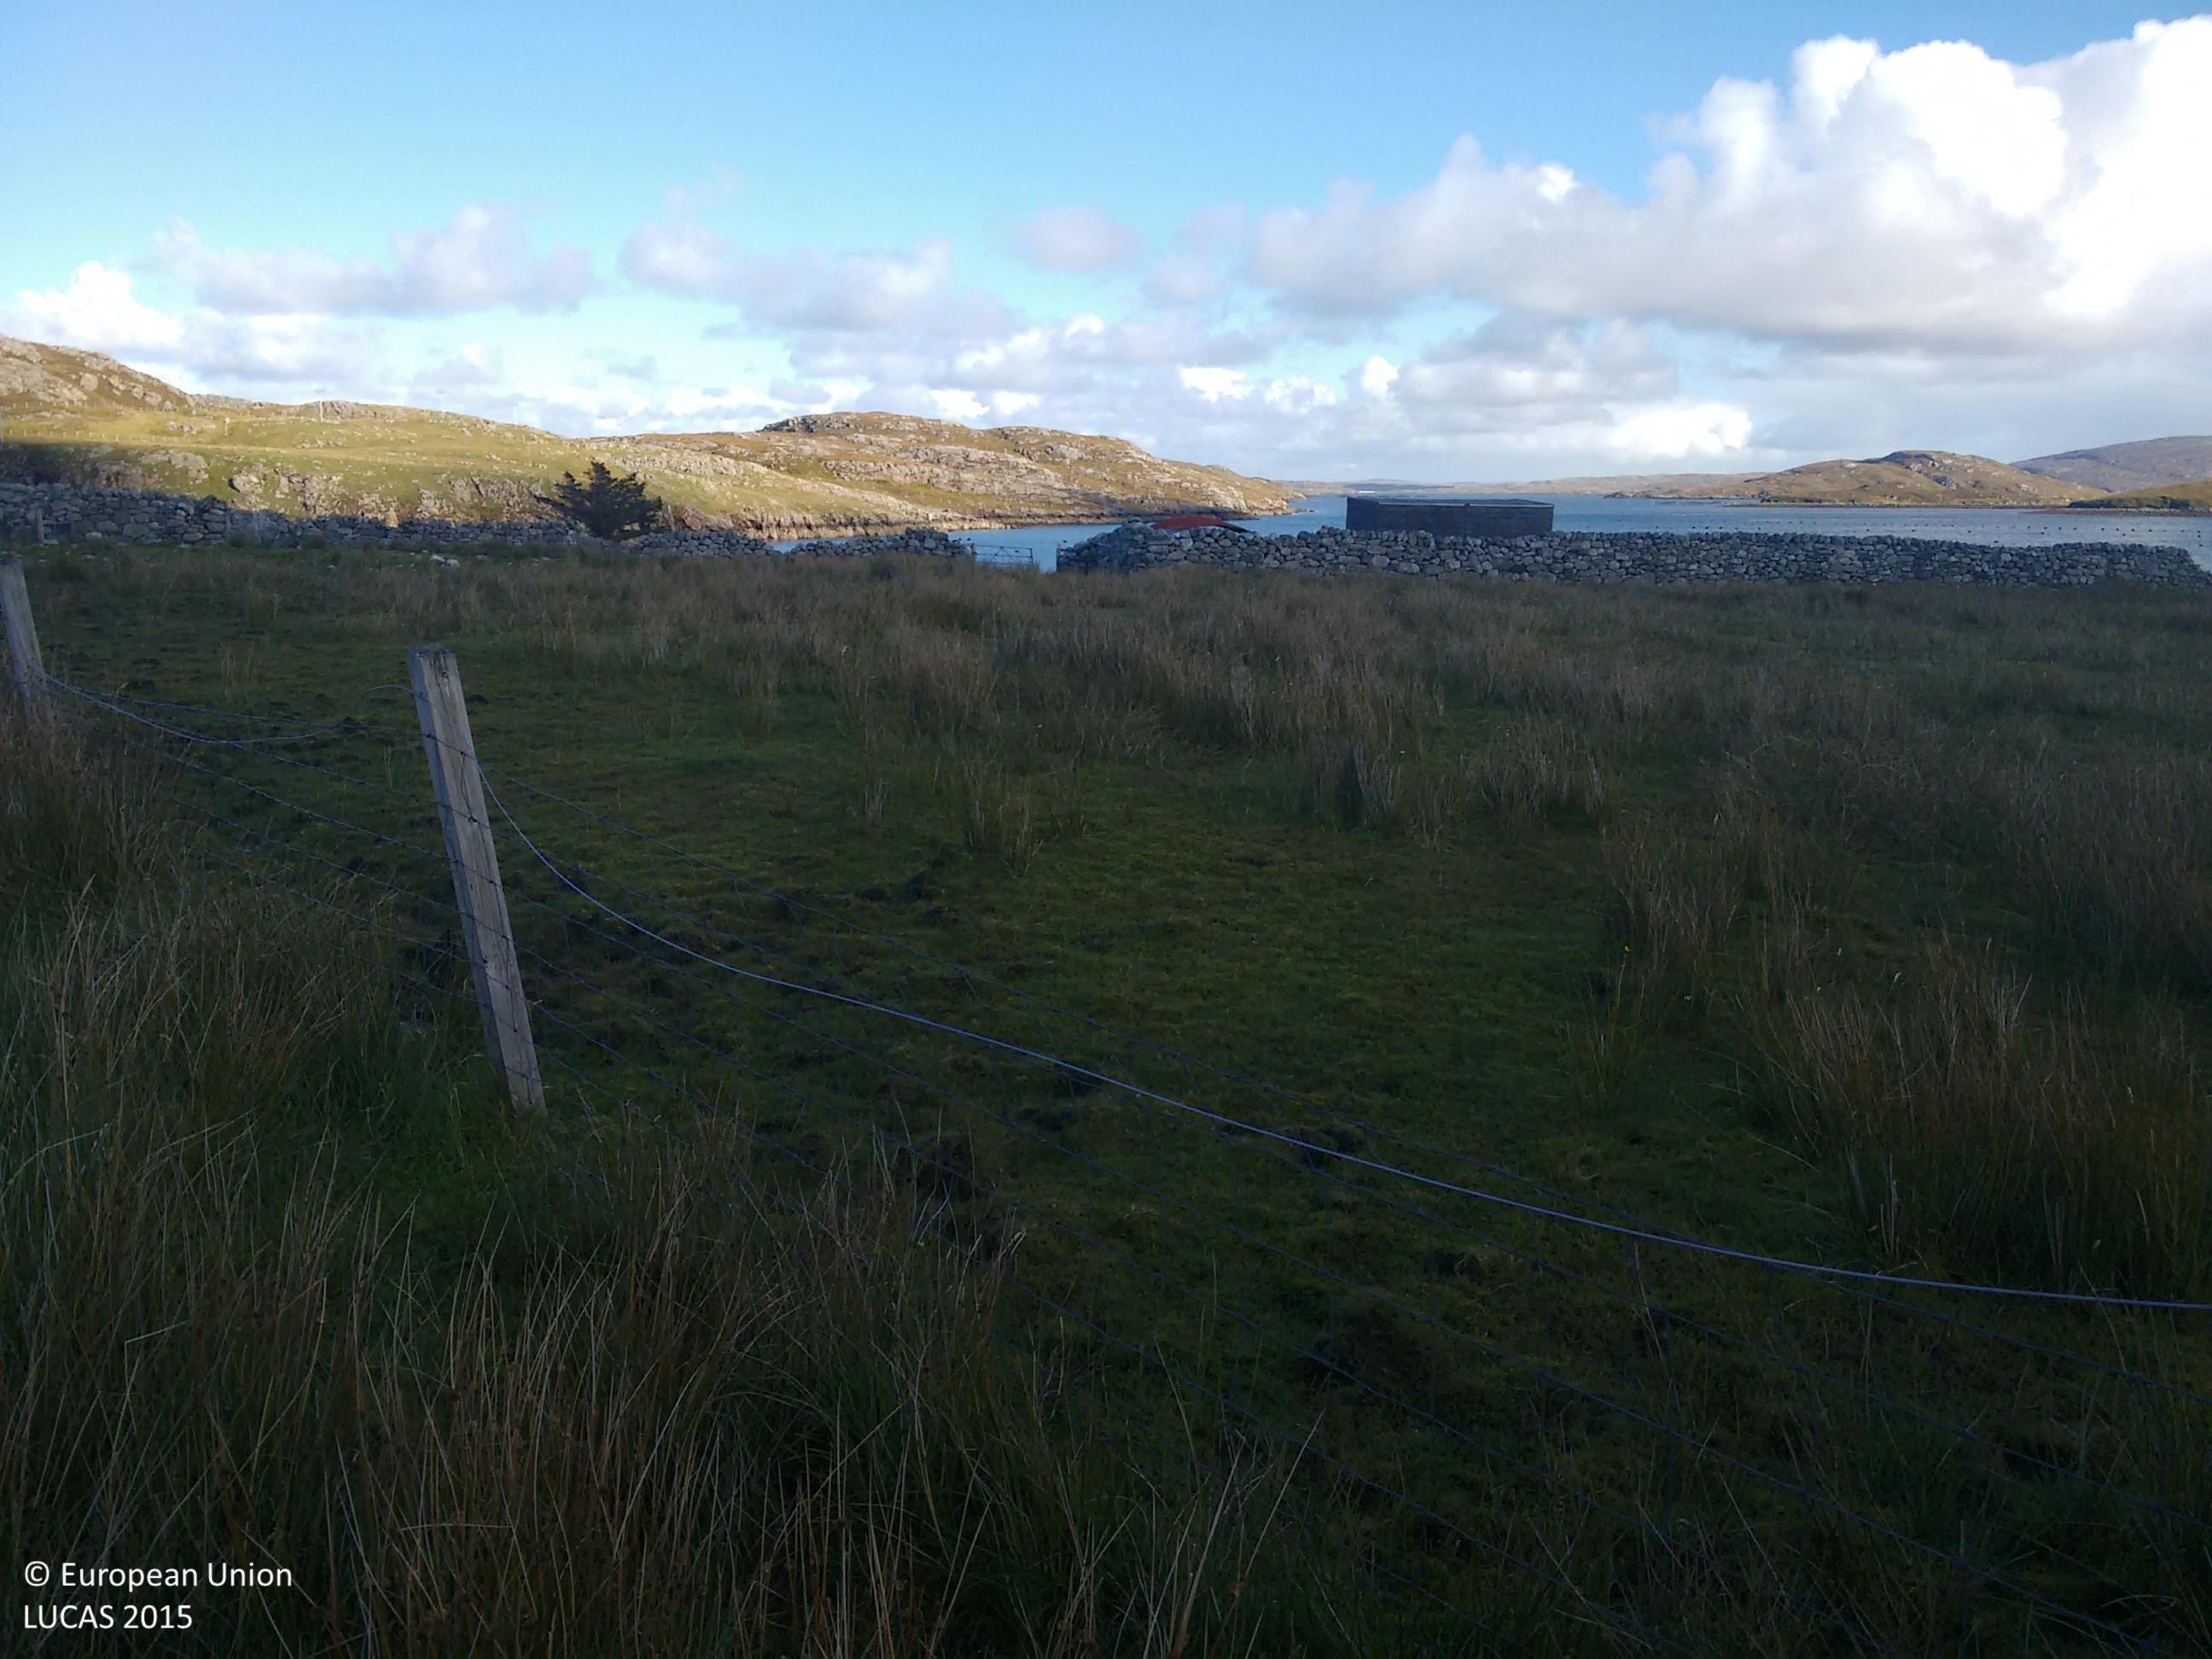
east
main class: Grassland
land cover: Grassland without tree/shrub cover
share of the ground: > 75 %
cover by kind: herbaceous plants 100 %
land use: Agriculture (excluding fallow land and kitchen gardens)
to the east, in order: Grassland without tree/shrub cover; Rock outcrops; Intertidal flats; Transitional water bodies
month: October
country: GB
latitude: 58.2012
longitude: -6.9452
